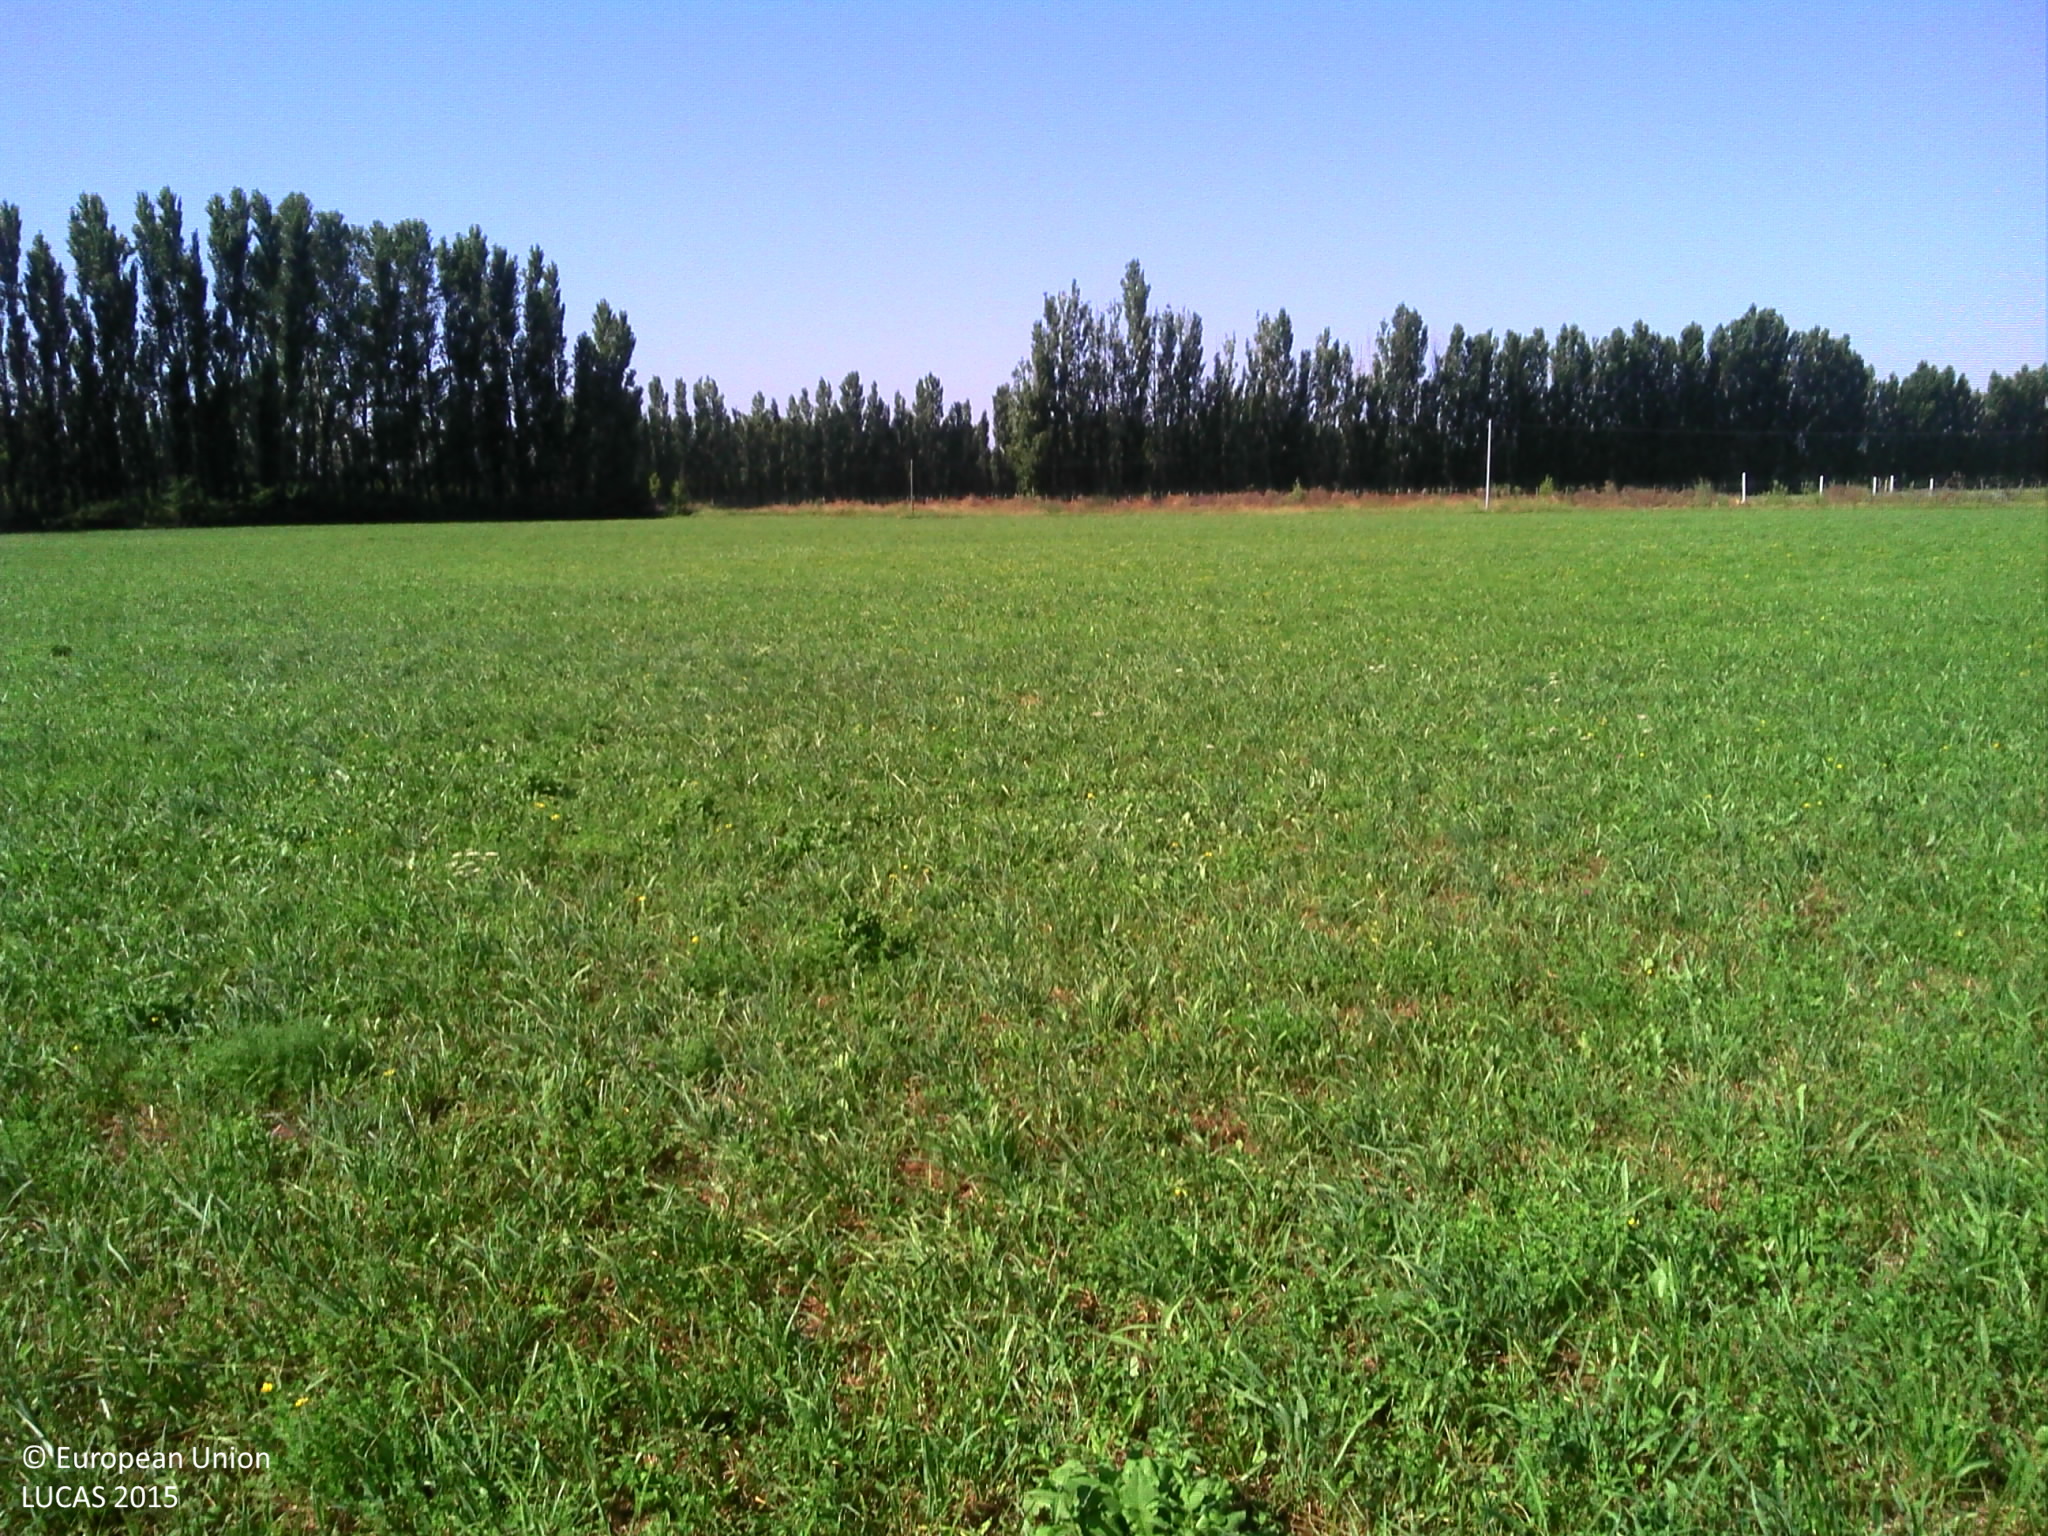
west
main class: Grassland
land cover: Grassland without tree/shrub cover
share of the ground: > 75 %
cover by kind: herbaceous plants 100 %
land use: Agriculture (excluding fallow land and kitchen gardens)
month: July
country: FR
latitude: 43.5848
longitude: 4.7462
